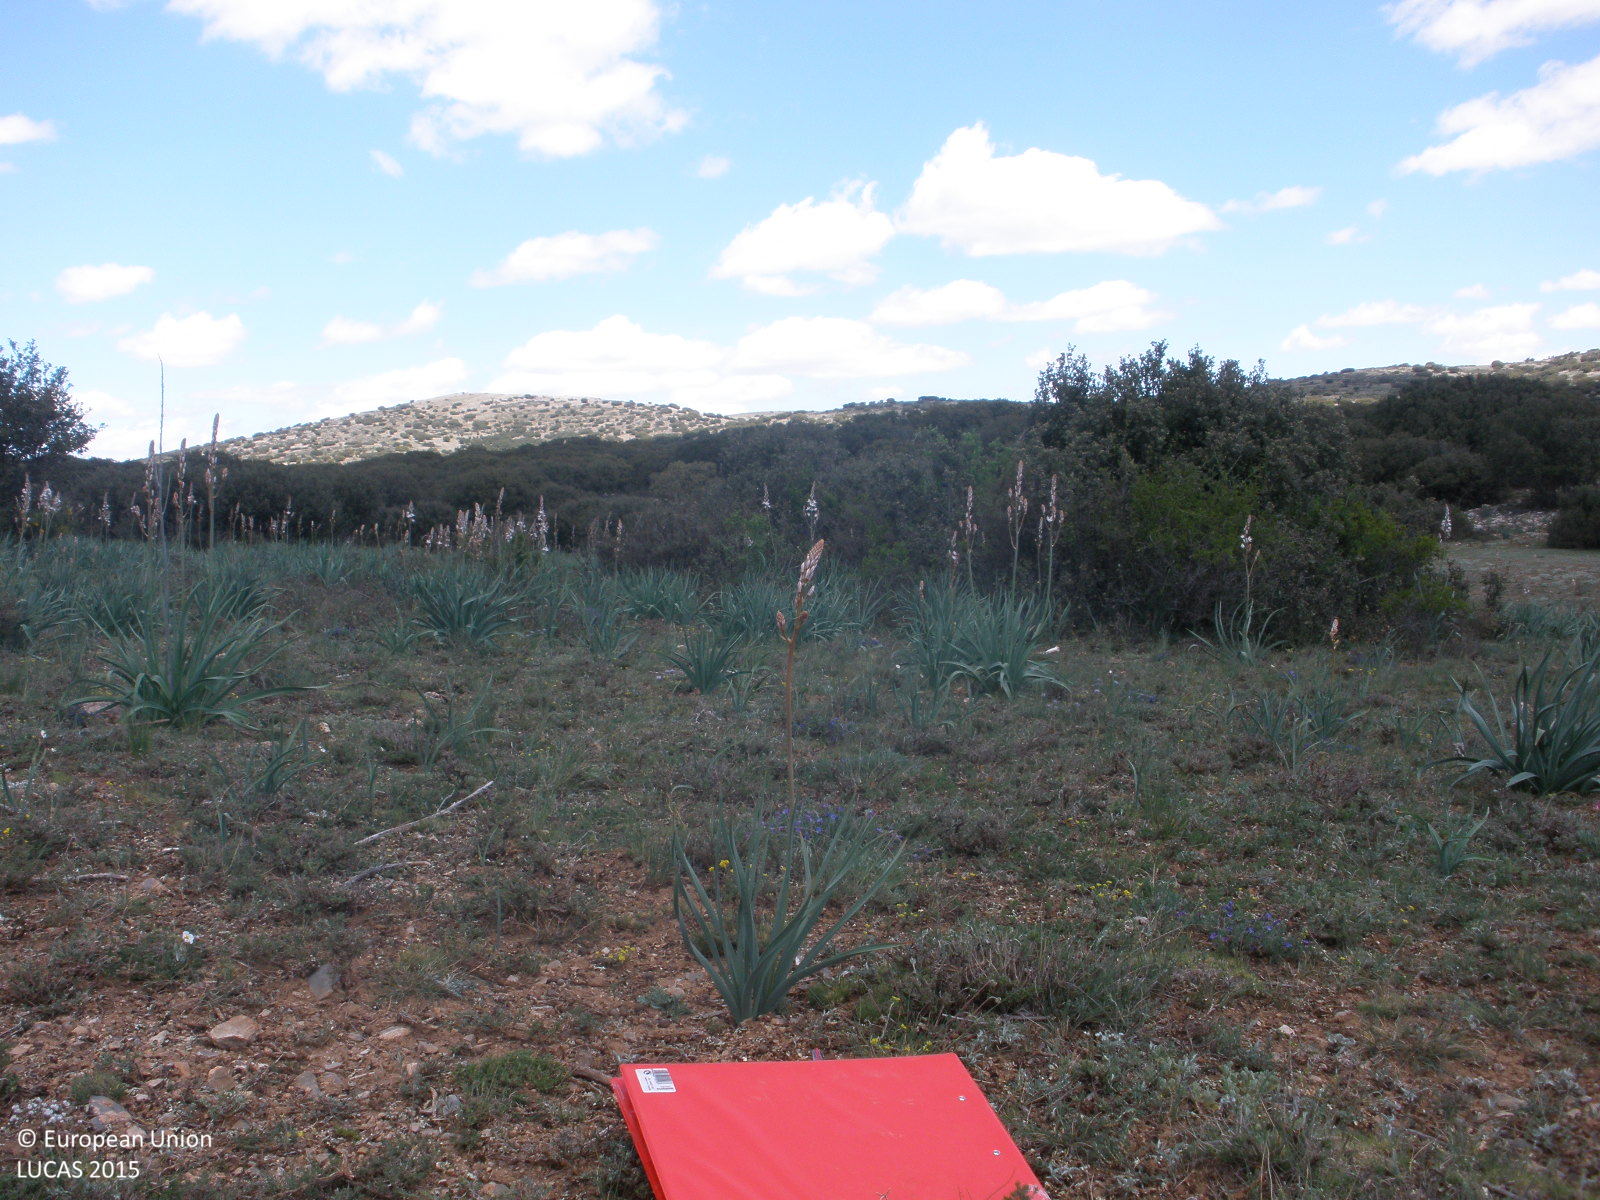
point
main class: Shrubland
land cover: Shrubland with sparse tree cover
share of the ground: 50 - 75 %
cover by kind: shrubs 55 %, herbaceous plants 30 %, consolidated bare surface 10 %, coniferous forest trees 5 %
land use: Semi-natural and natural areas not in use
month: May
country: ES
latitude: 40.7137
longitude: -1.0822
